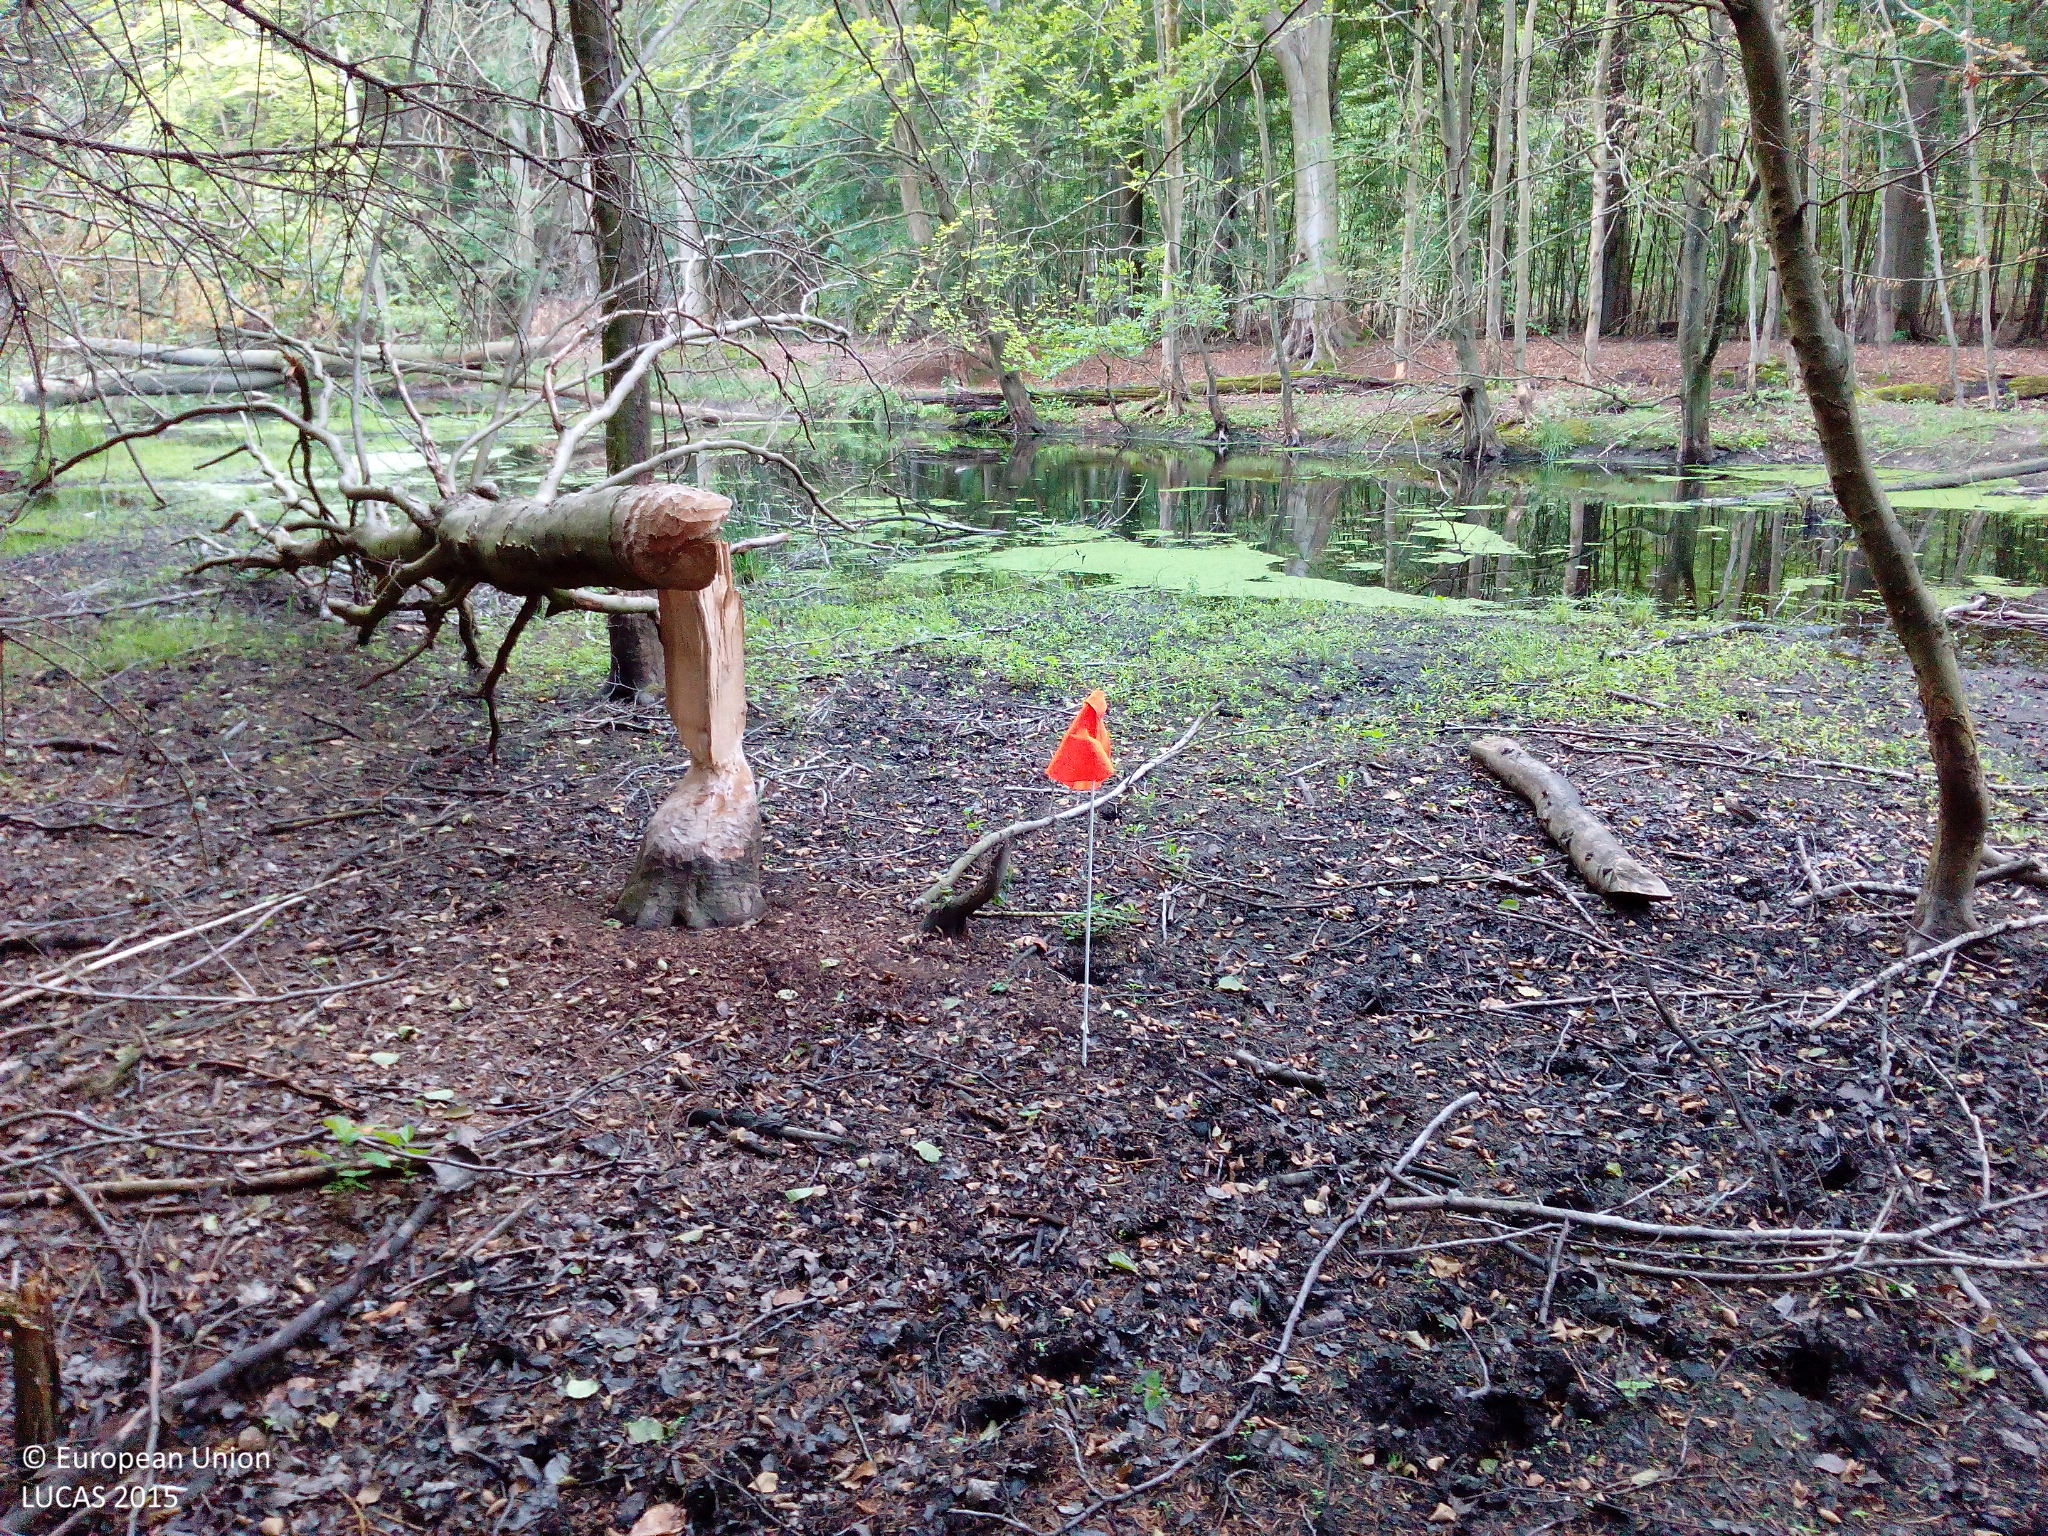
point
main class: Woodland
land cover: Spruce dominated mixed woodland
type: hemiboreal forest and nemoral coniferous forest and mixed broadleaved-coniferous forest
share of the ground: > 75 %
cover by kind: coniferous forest trees 75 %, broadleaved forest trees 25 %
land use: Forestry
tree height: > 5 m
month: July
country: DE
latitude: 52.8265
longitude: 13.6066
